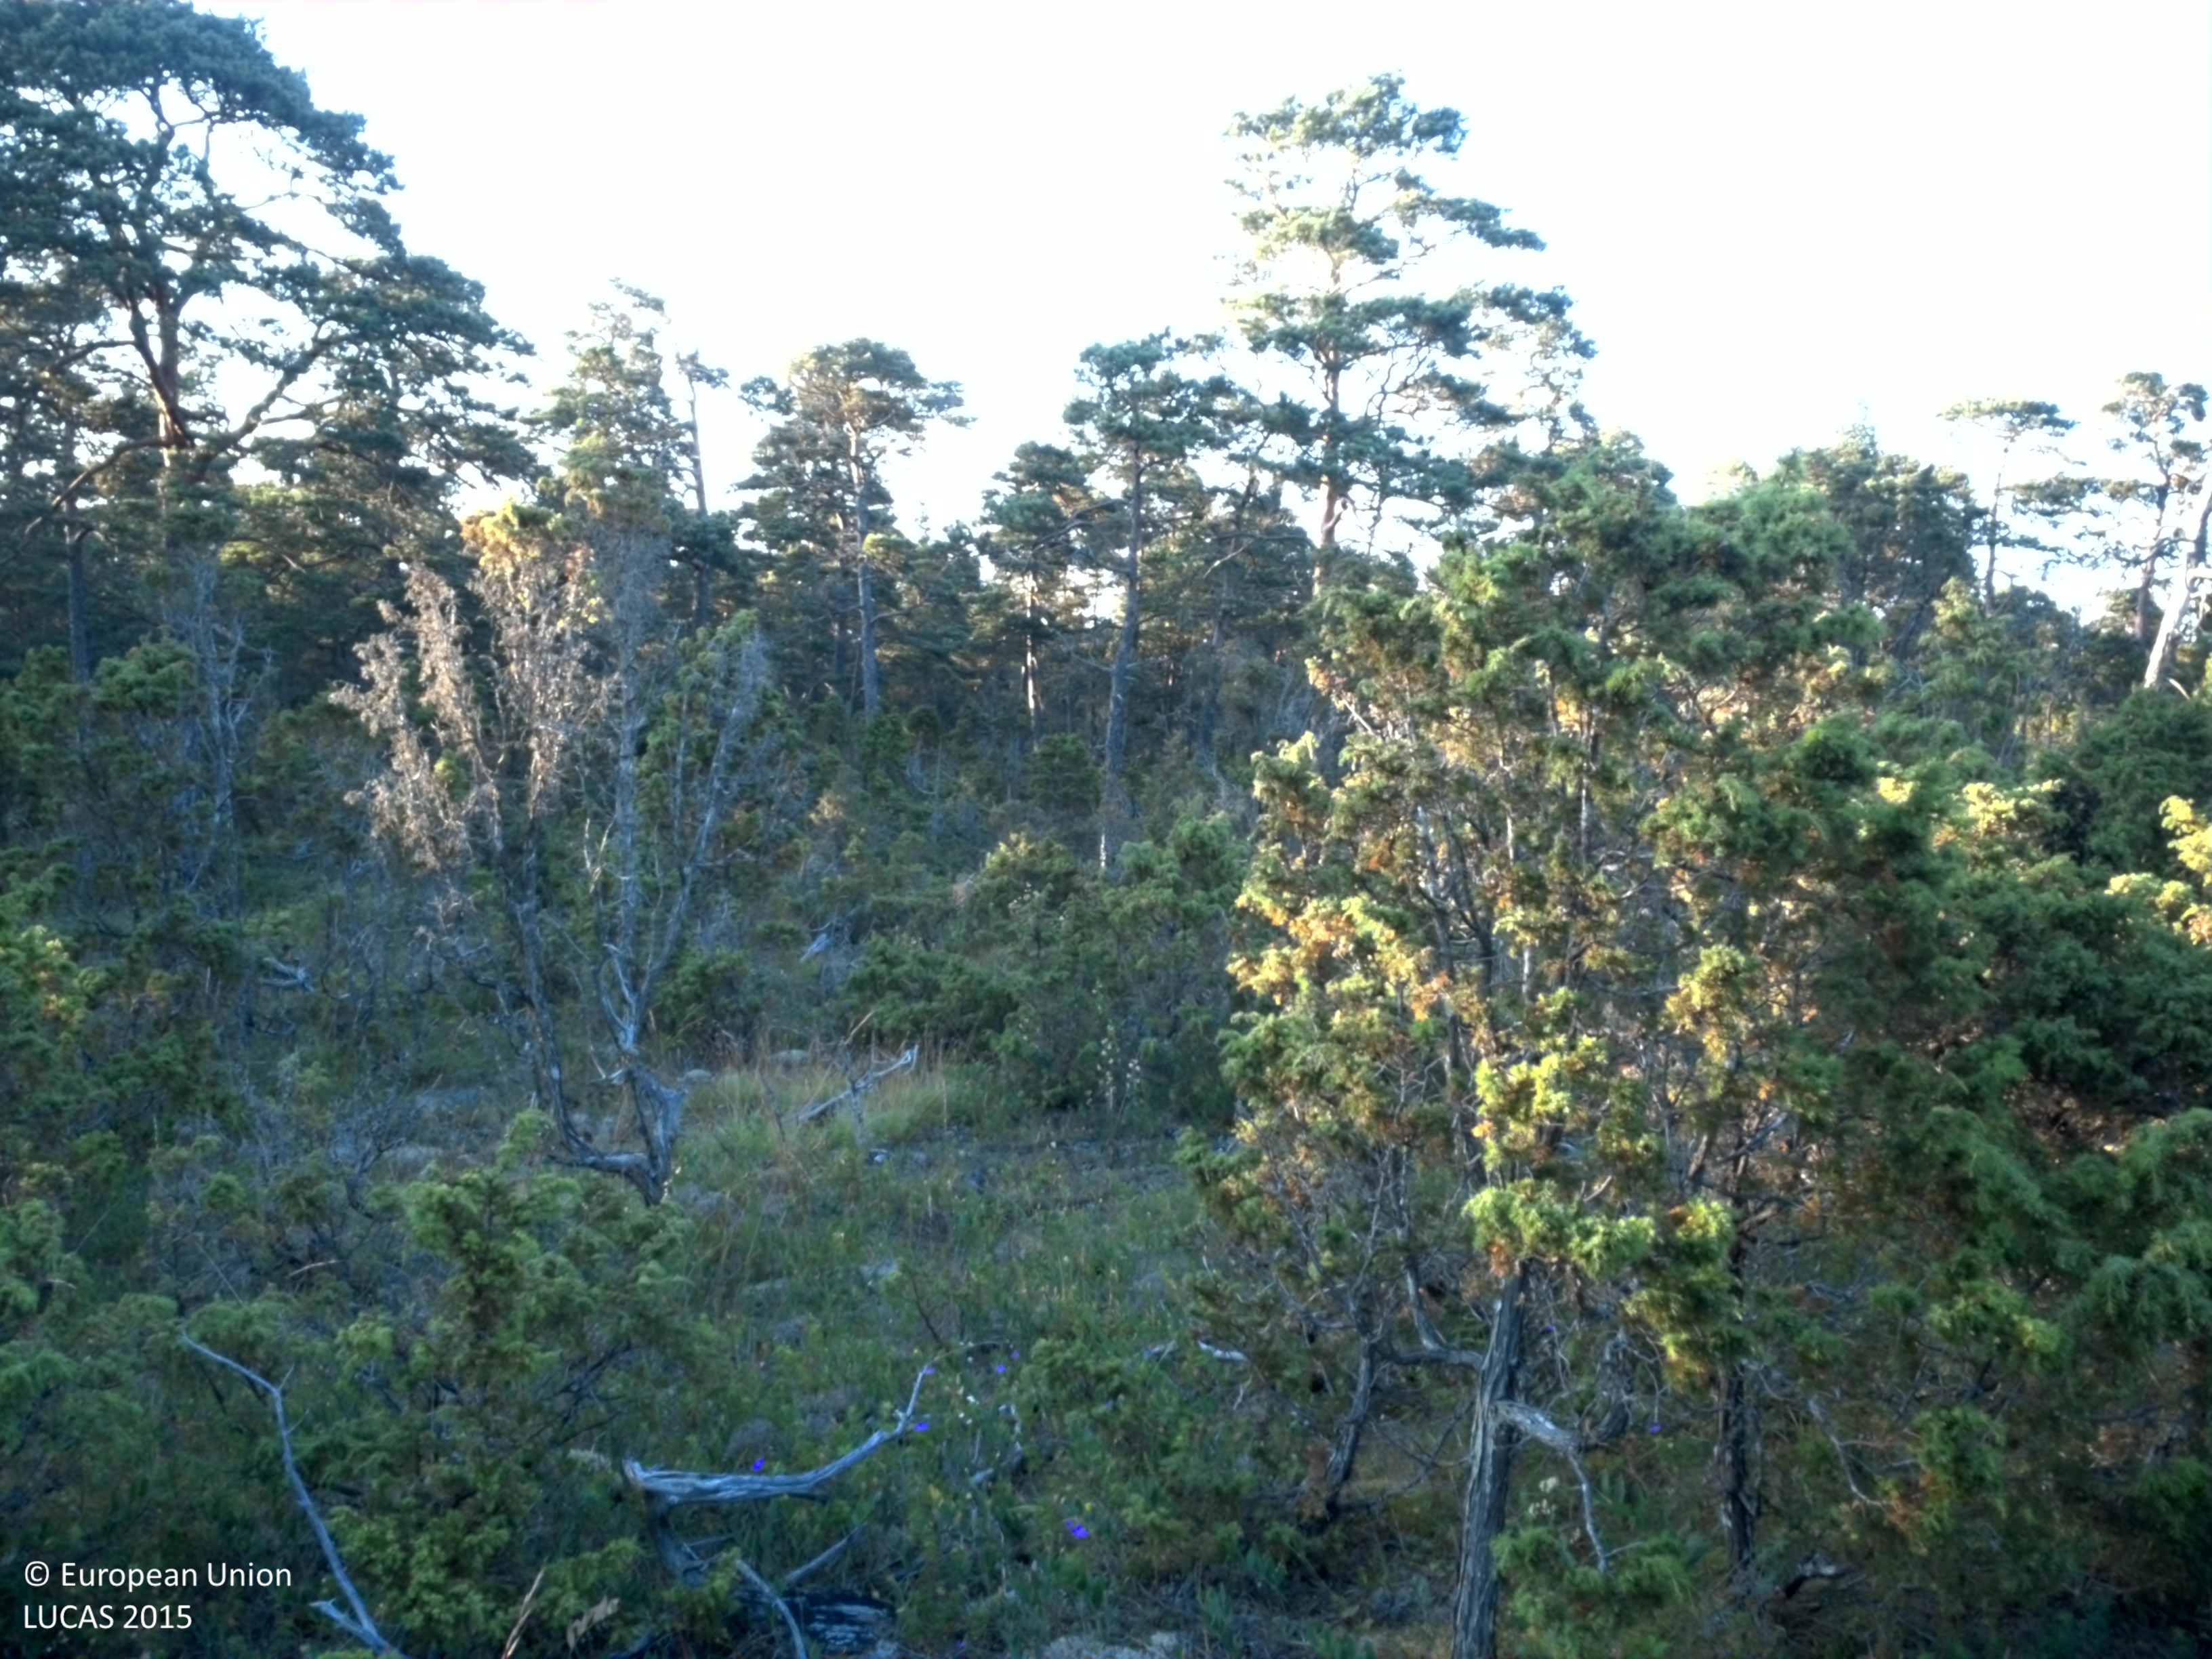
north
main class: Shrubland
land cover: Shrubland with sparse tree cover
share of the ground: > 75 %
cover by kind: shrubs 75 %, herbaceous plants 15 %, coniferous forest trees 5 %, lichens and mosses 5 %
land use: Semi-natural and natural areas not in use
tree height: > 5 m
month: July
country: SE
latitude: 57.3975
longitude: 18.6465
